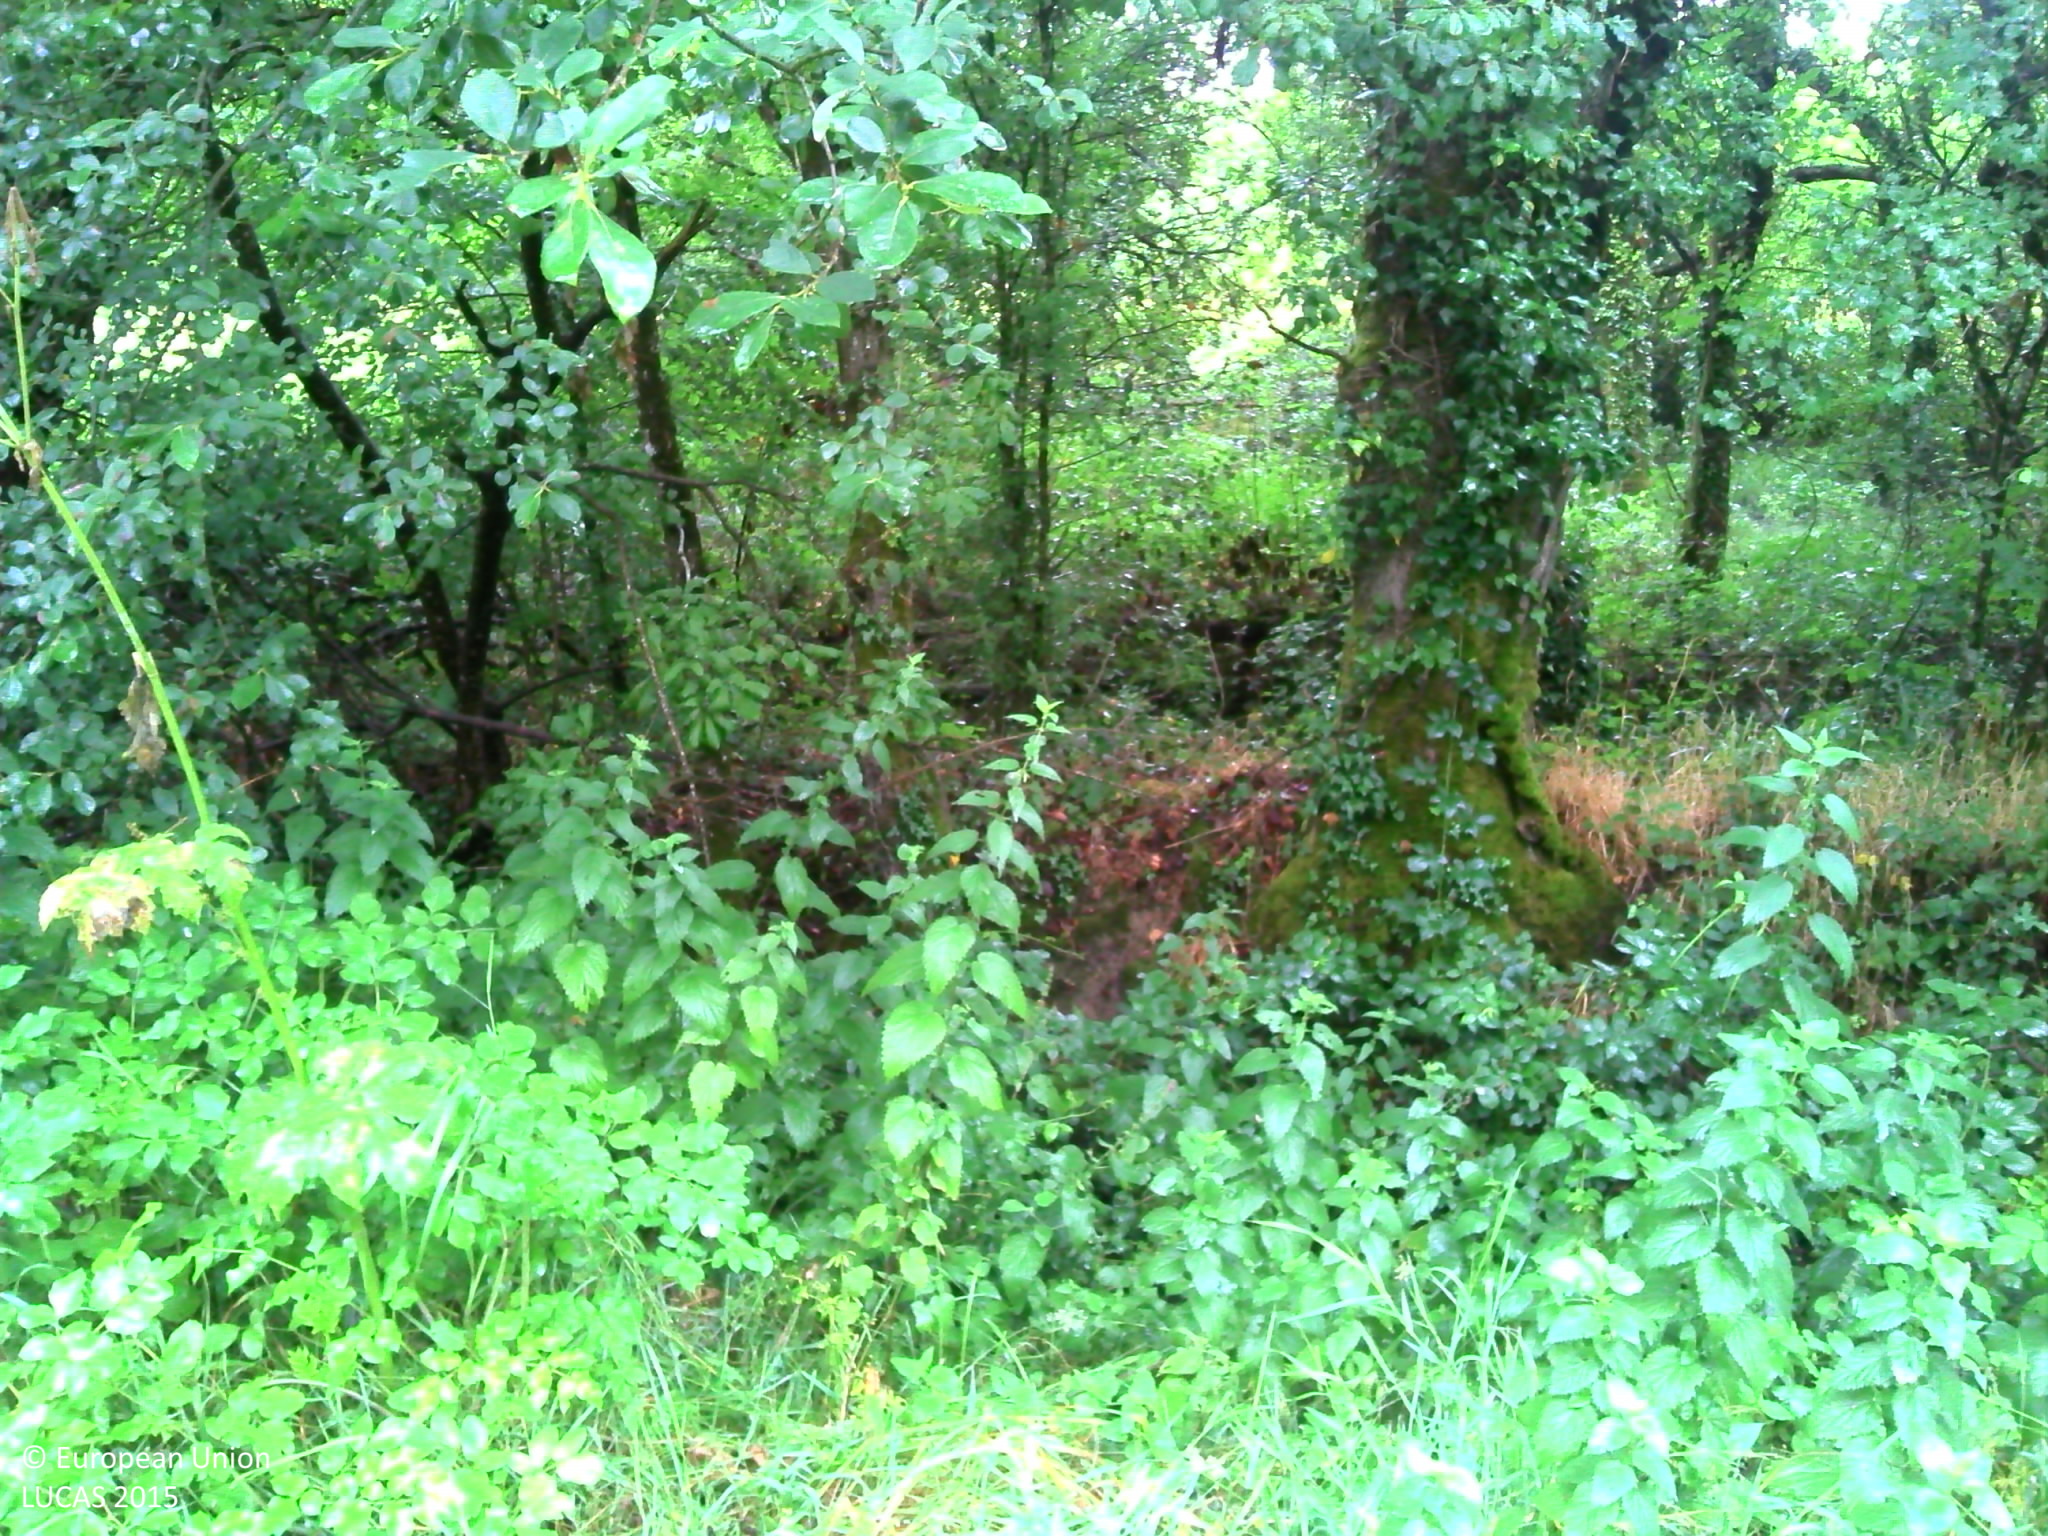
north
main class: Woodland
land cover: Broadleaved woodland
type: acidophilous oak and oak-birch forest
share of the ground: > 75 %
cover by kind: broadleaved forest trees 60 %, shrubs 15 %, herbaceous plants 15 %, consolidated bare surface 10 %
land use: Forestry
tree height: > 5 m
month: July
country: FR
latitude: 47.7477
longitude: -3.0992
